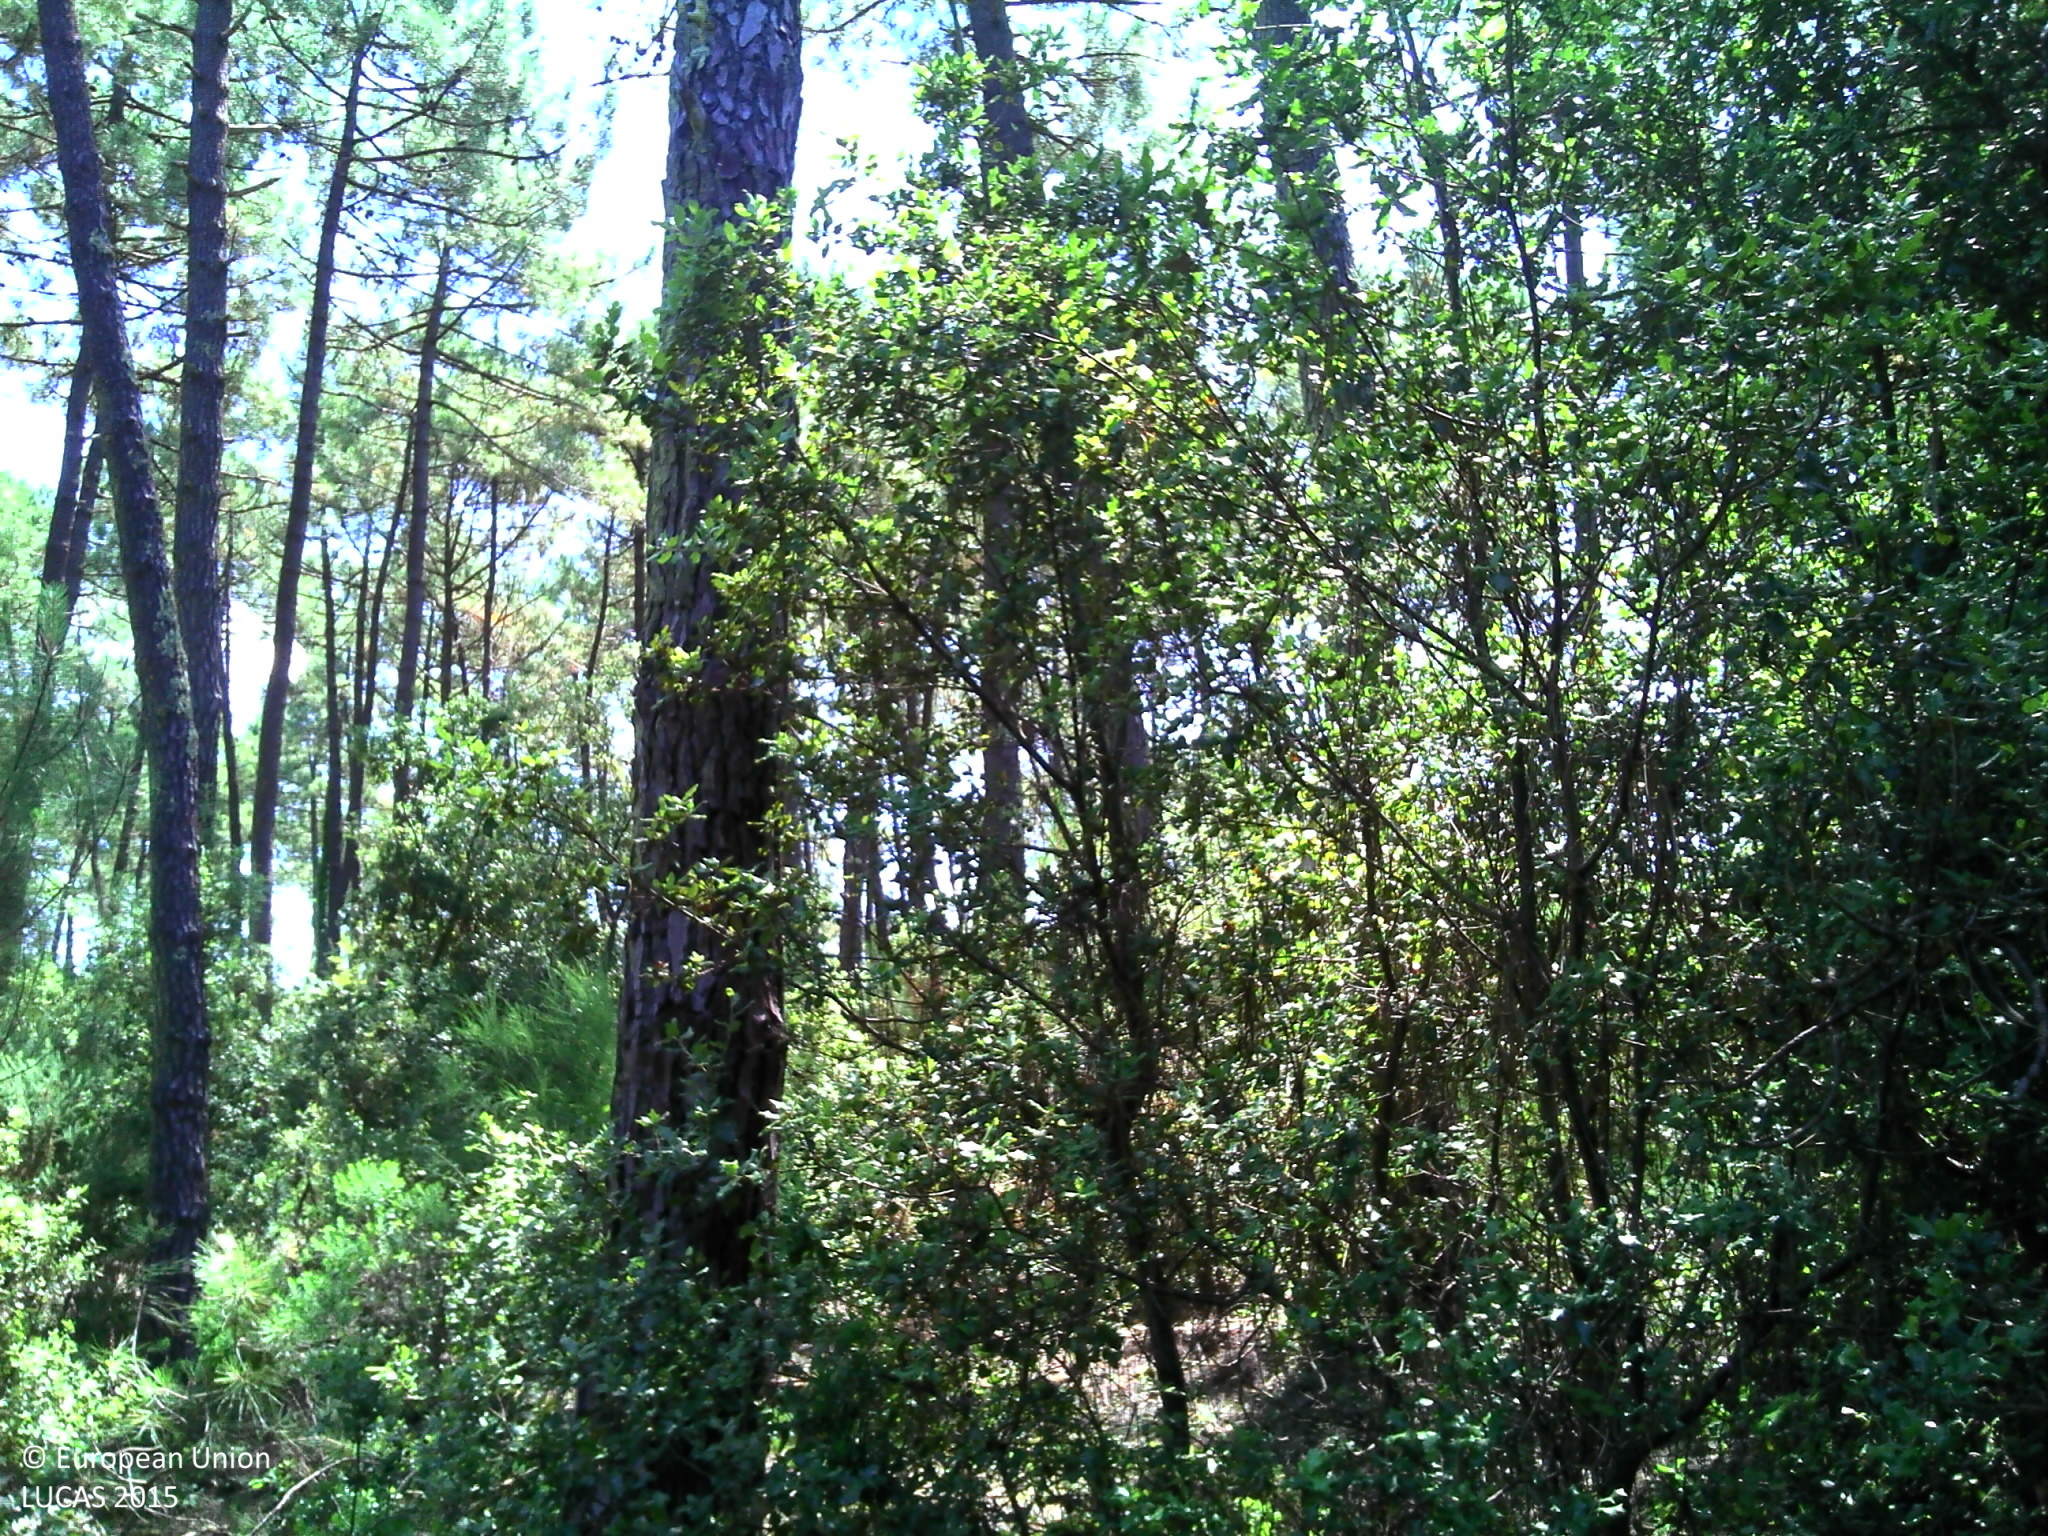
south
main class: Woodland
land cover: Pine dominated mixed woodland
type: coniferous forest of the mediterranean region
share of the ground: > 75 %
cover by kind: coniferous forest trees 75 %, broadleaved forest trees 25 %
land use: Forestry
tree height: > 5 m
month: June
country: FR
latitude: 45.7073
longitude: -1.1921
